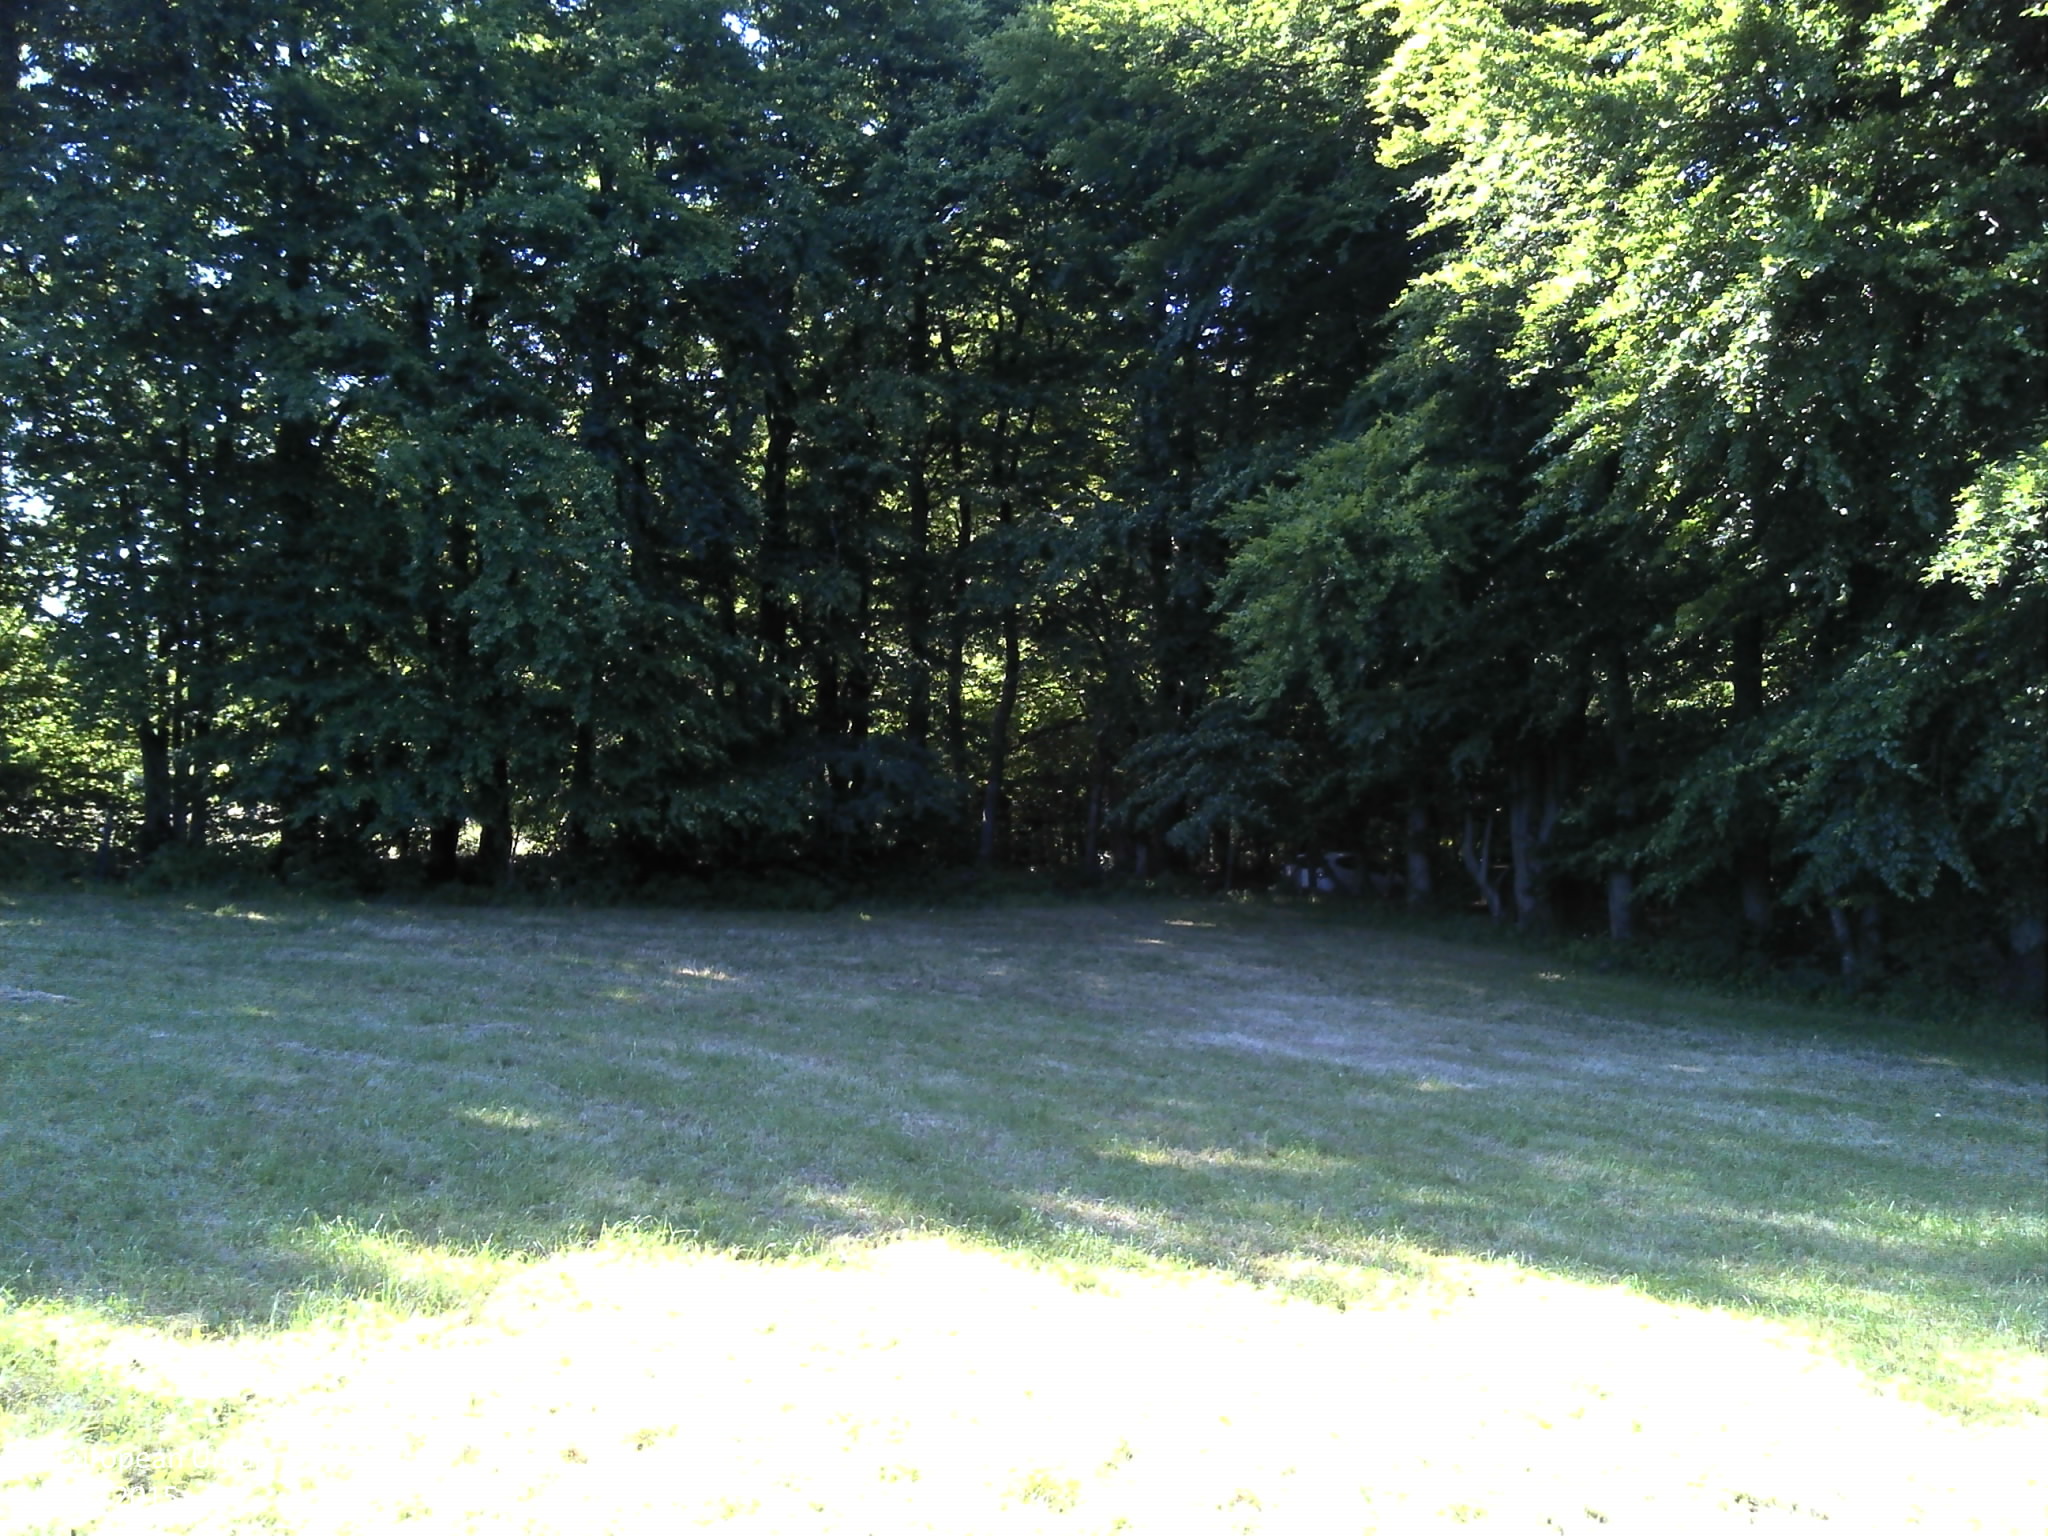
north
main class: Grassland
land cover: Grassland without tree/shrub cover
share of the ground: > 75 %
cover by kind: herbaceous plants 100 %
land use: Agriculture (excluding fallow land and kitchen gardens)
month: June
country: FR
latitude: 49.9574
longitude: 4.7977
